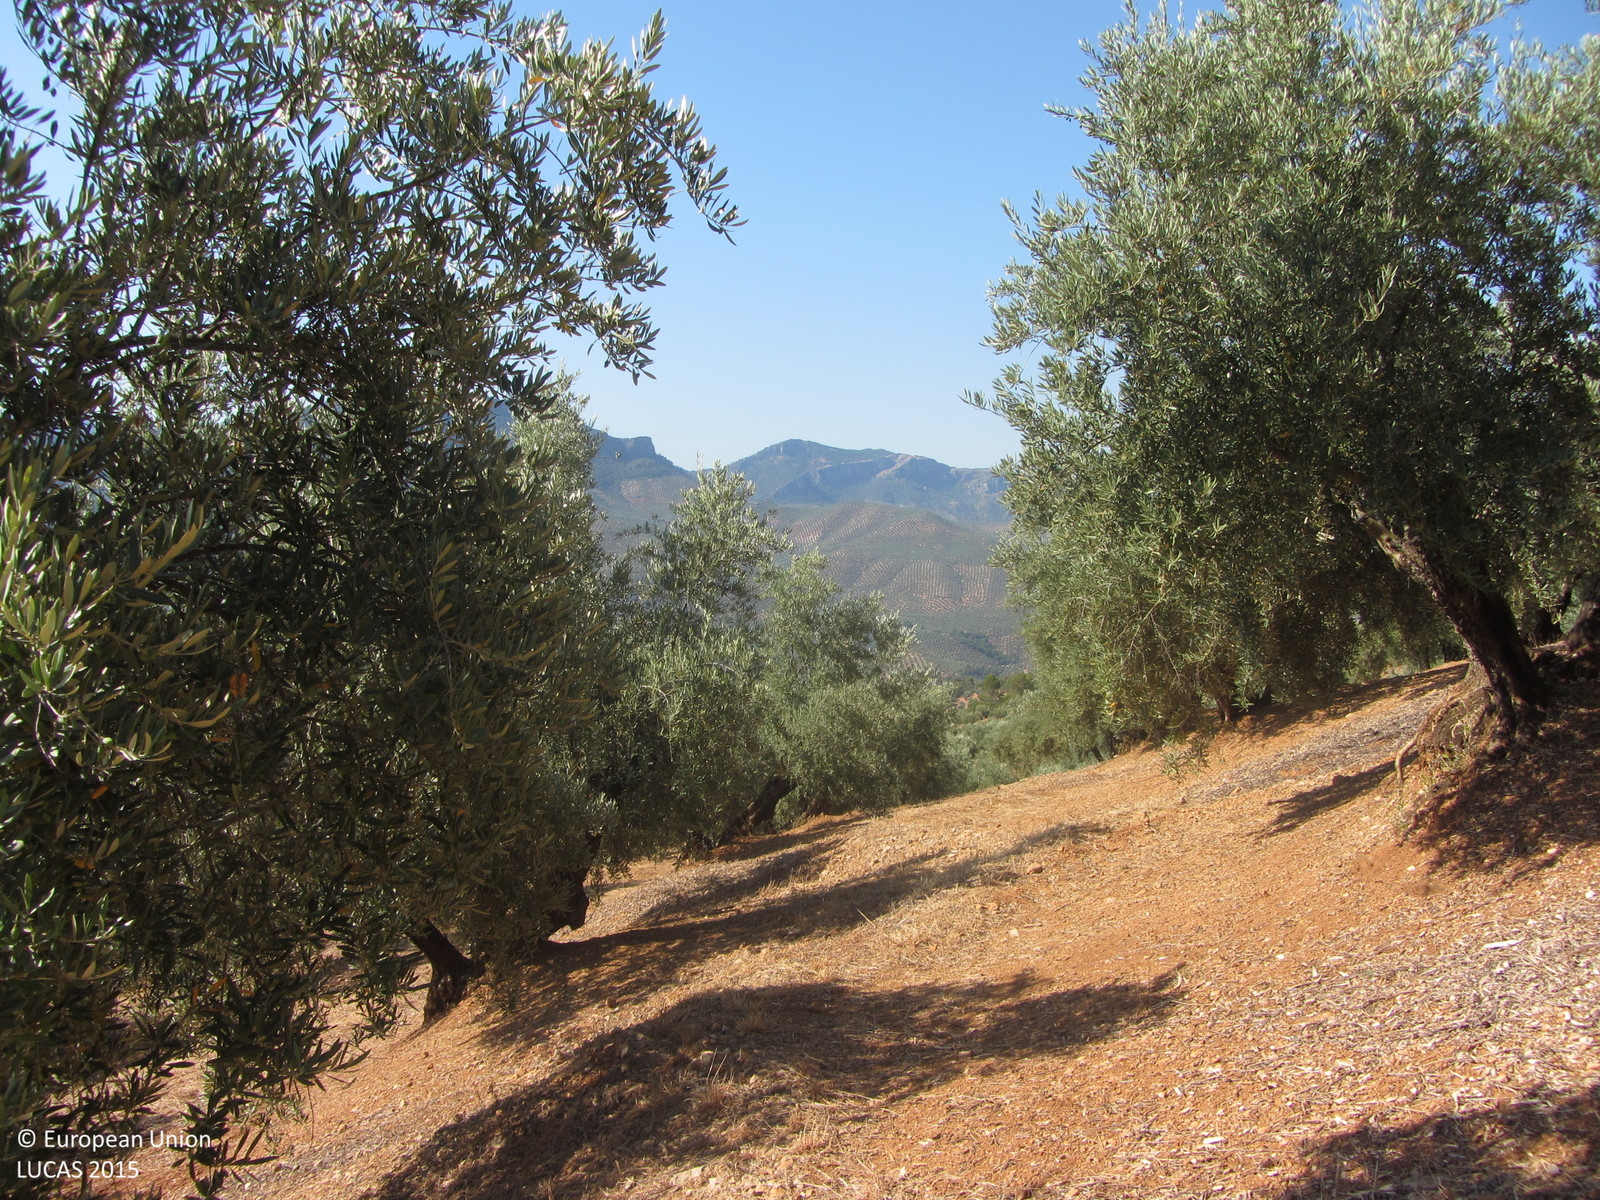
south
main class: Cropland
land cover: Olive groves
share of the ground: 25 - 50 %
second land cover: Other bare soil
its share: > 75 %
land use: Agriculture (excluding fallow land and kitchen gardens)
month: June
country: ES
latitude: 38.2014
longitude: -2.9137
